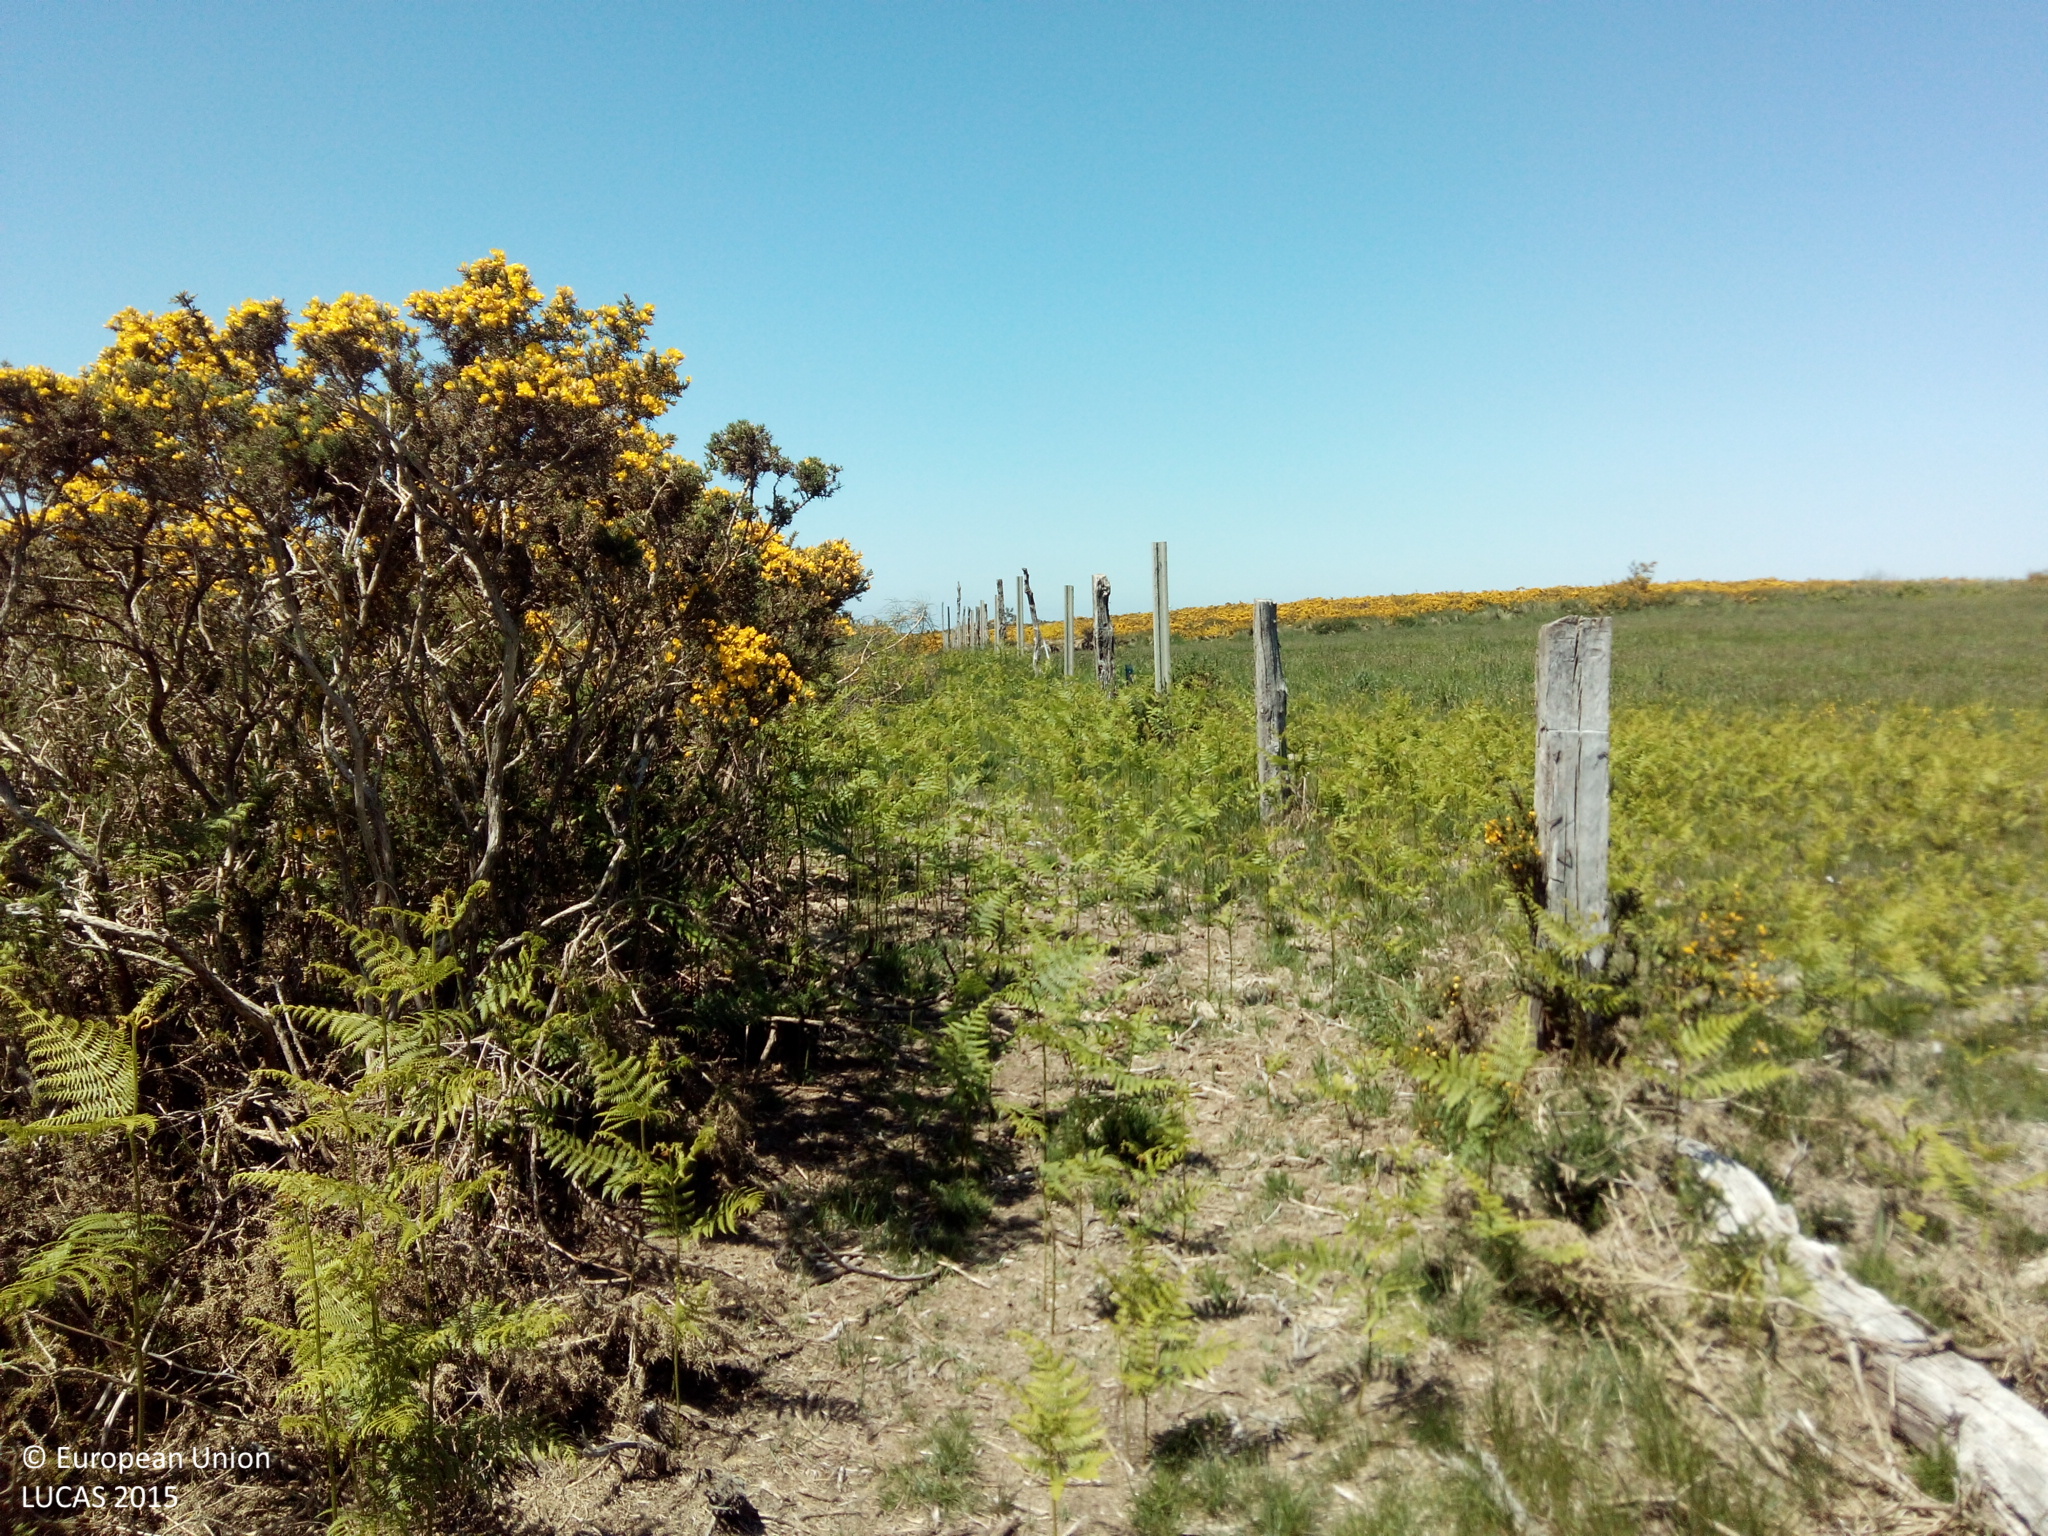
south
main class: Shrubland
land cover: Shrubland without tree cover
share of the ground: > 75 %
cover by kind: shrubs 100 %
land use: Abandoned areas
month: May
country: ES
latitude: 42.6234
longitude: -8.3474
